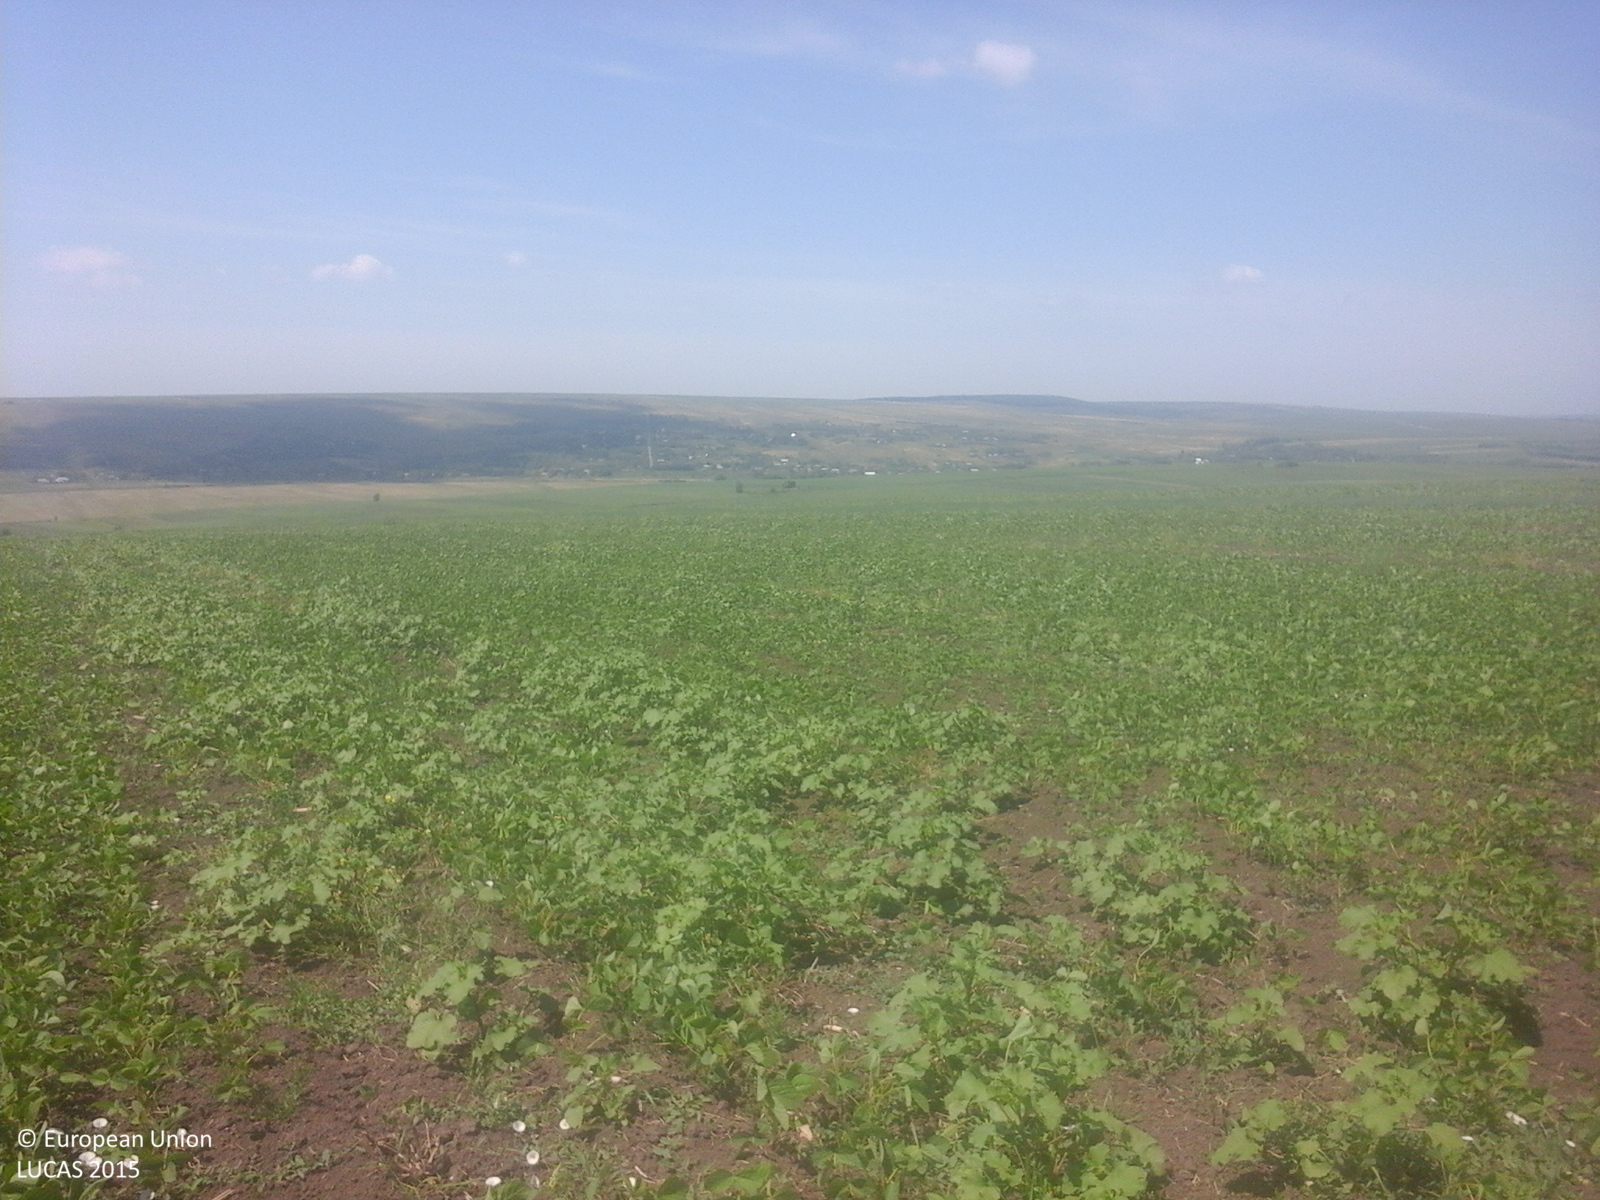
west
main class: Cropland
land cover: Soya
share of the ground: 25 - 50 %
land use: Agriculture (excluding fallow land and kitchen gardens)
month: June
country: RO
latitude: 47.8273
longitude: 27.0036
